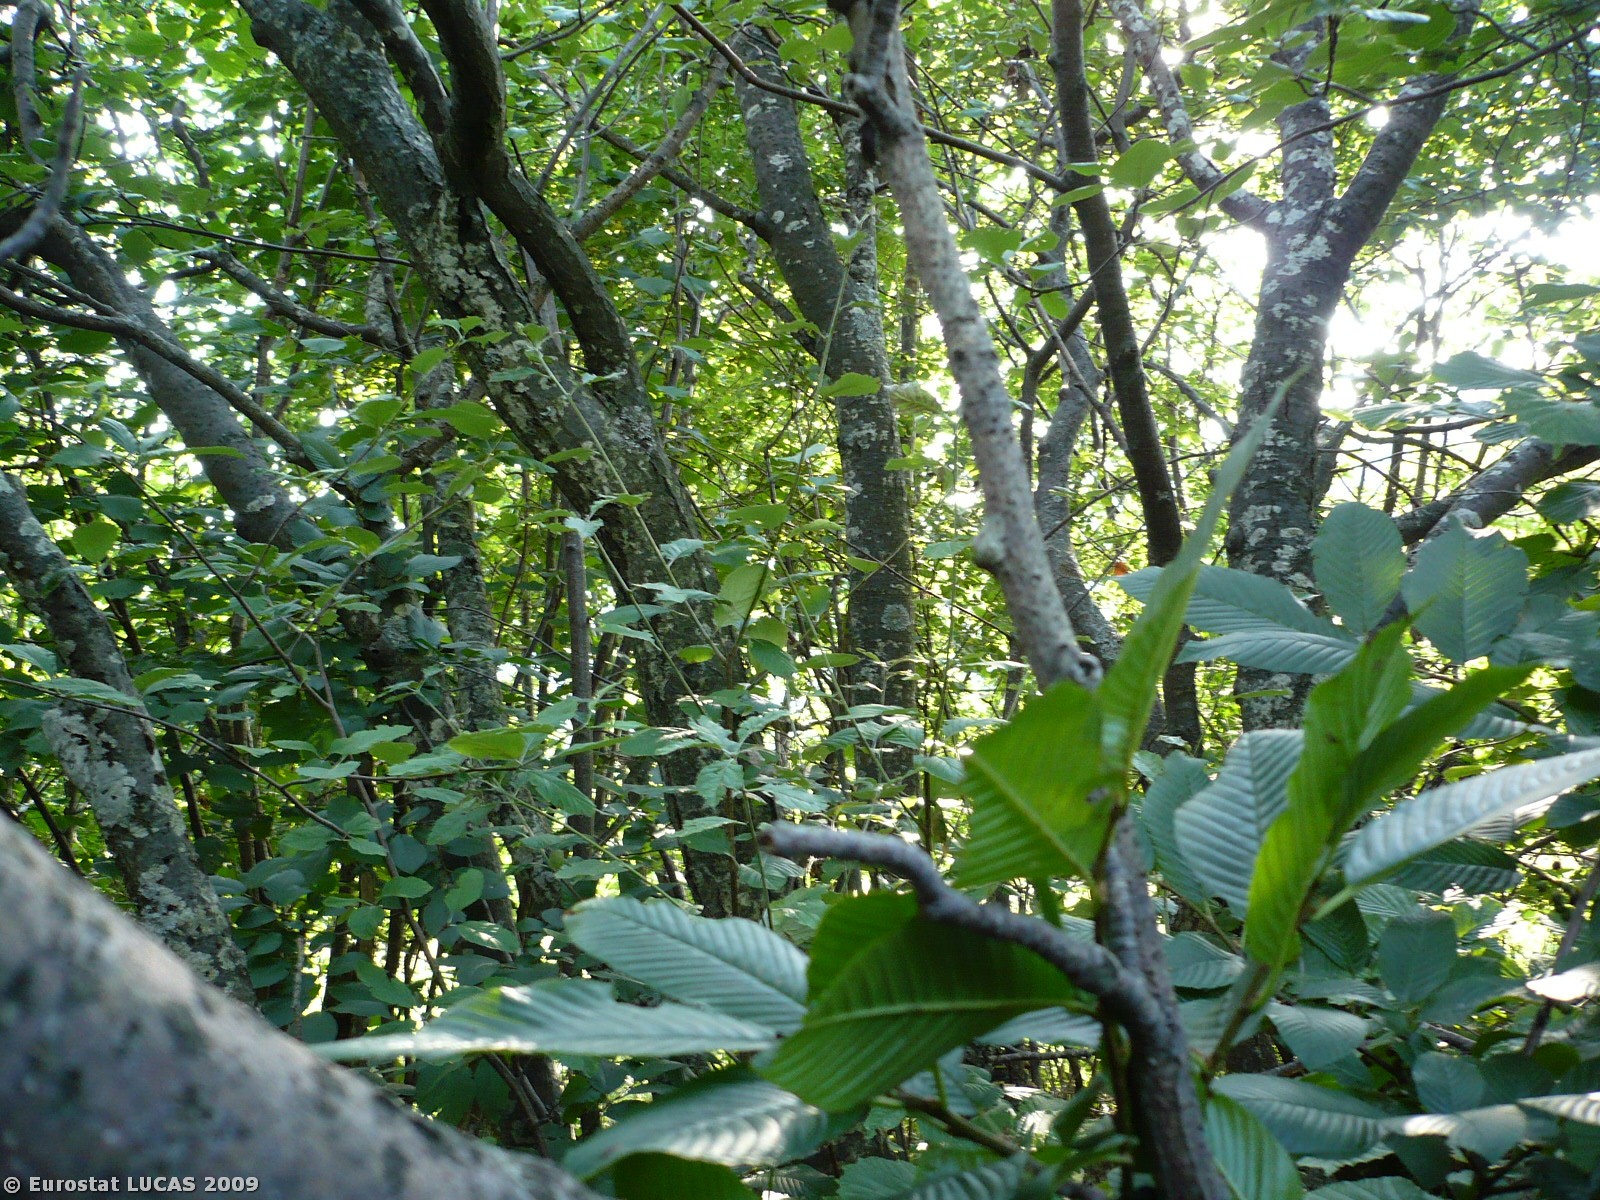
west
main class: Woodland
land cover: Broadleaved woodland
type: thermophilous deciduous forest
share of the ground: > 75 %
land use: Unused
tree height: > 5 m
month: July
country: SI
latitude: 45.5607
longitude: 14.3129
